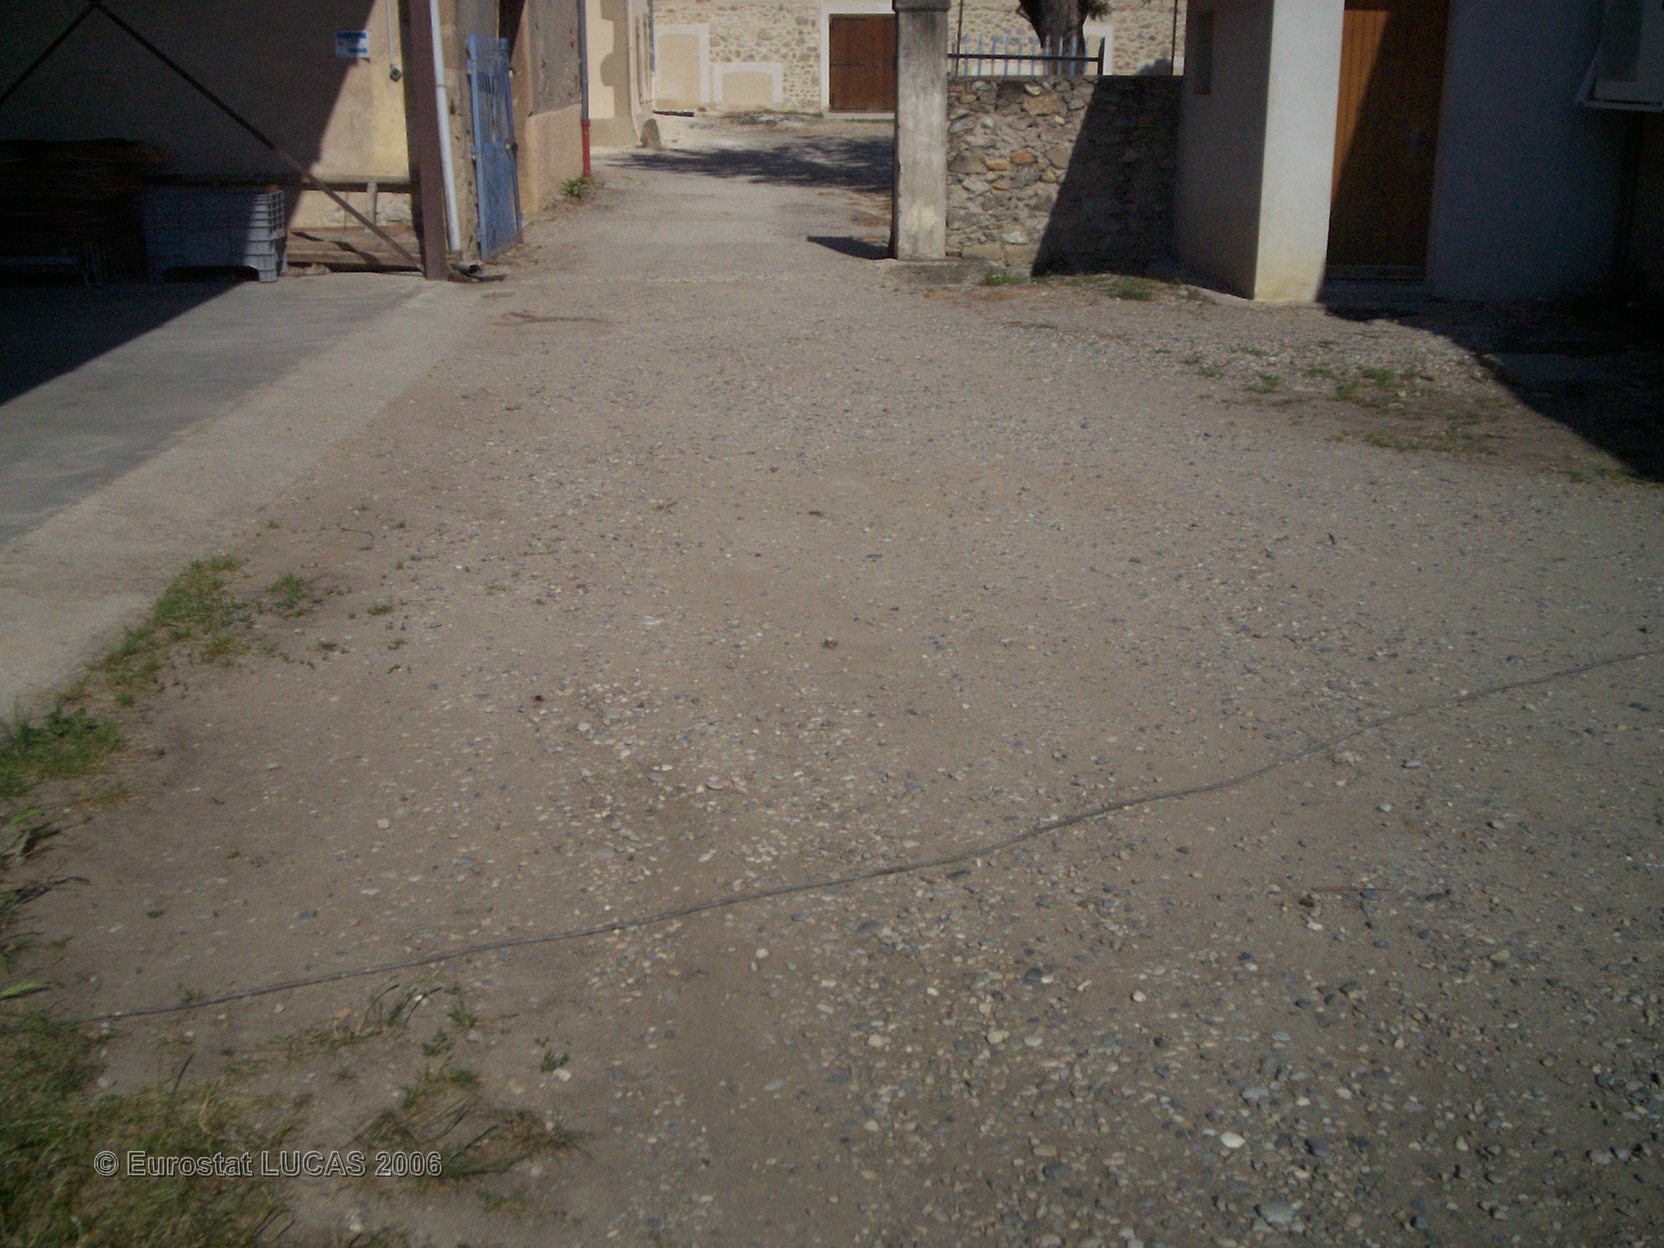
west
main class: Cropland
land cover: Other fruit trees and berries
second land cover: Grassland with sparse tree/shrub cover
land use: Agriculture (excluding fallow land and kitchen gardens)
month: June
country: FR
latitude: 45.0723
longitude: 4.8611
